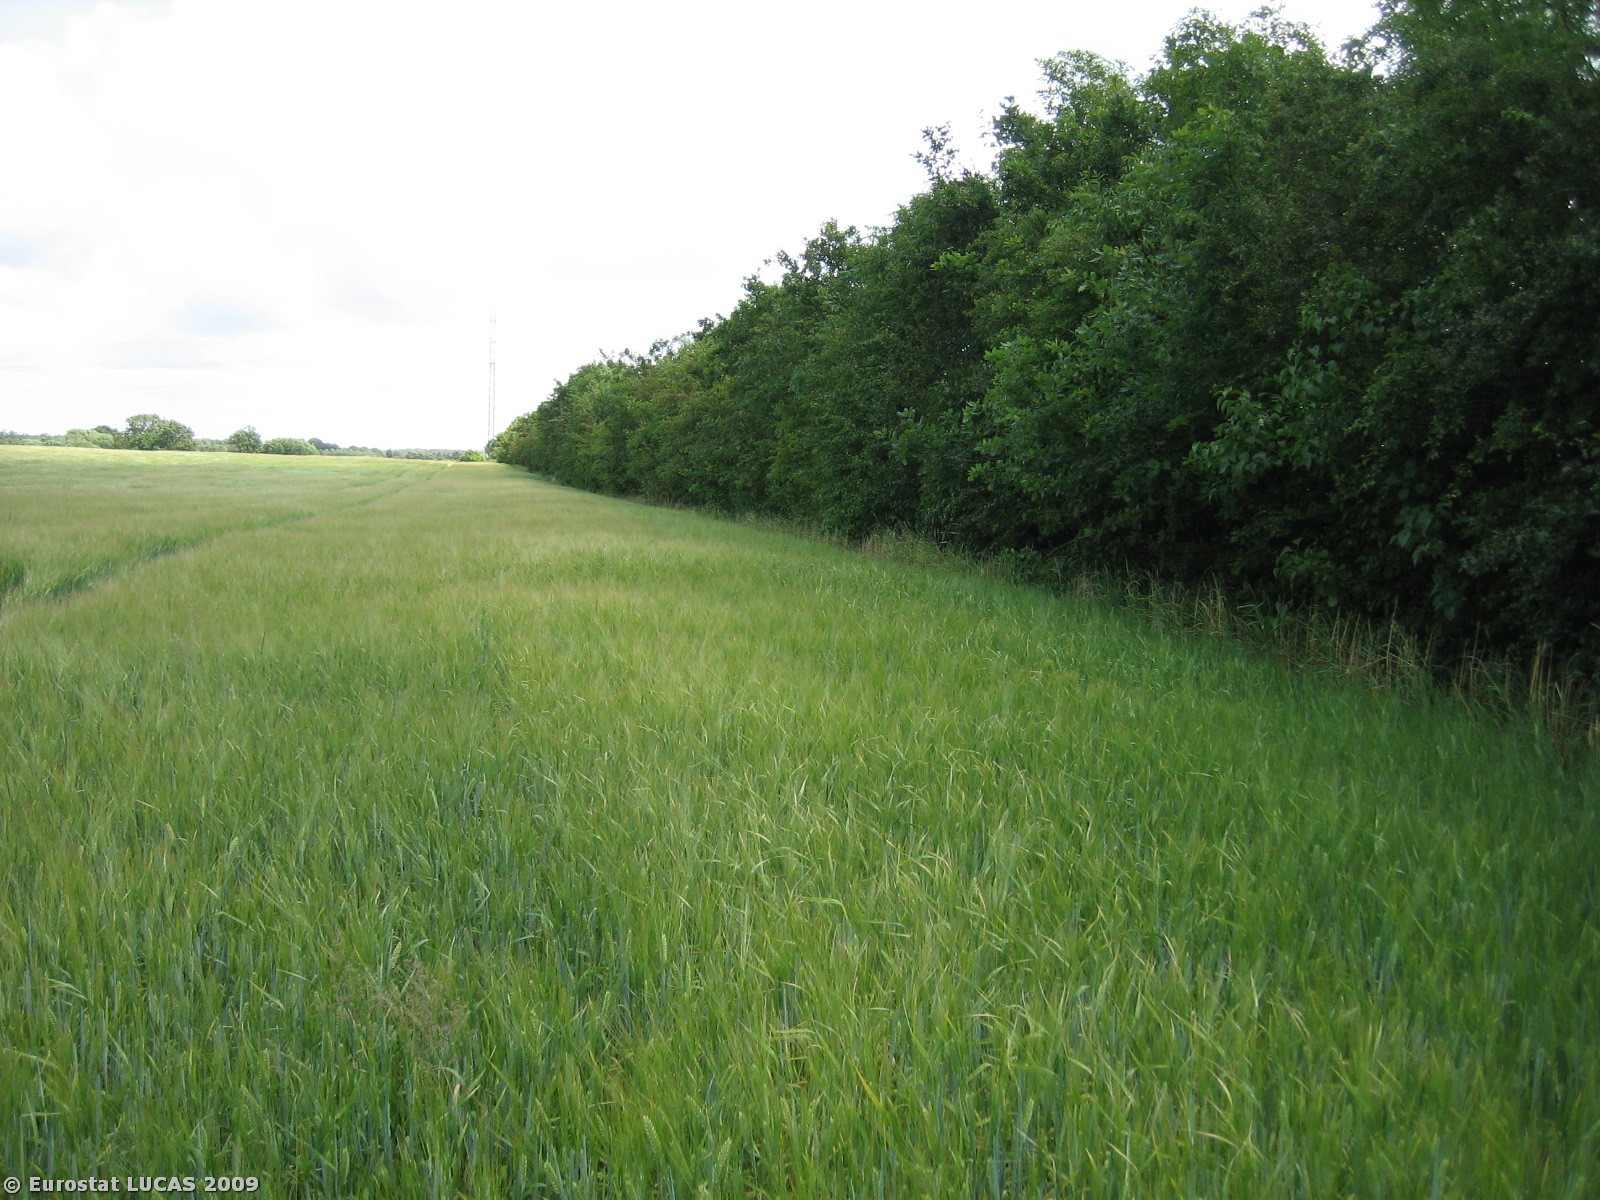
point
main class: Cropland
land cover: Barley
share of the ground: > 75 %
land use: Agriculture (excluding fallow land and kitchen gardens)
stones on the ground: < 10 %
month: July
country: DK
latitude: 55.6942
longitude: 8.5536
